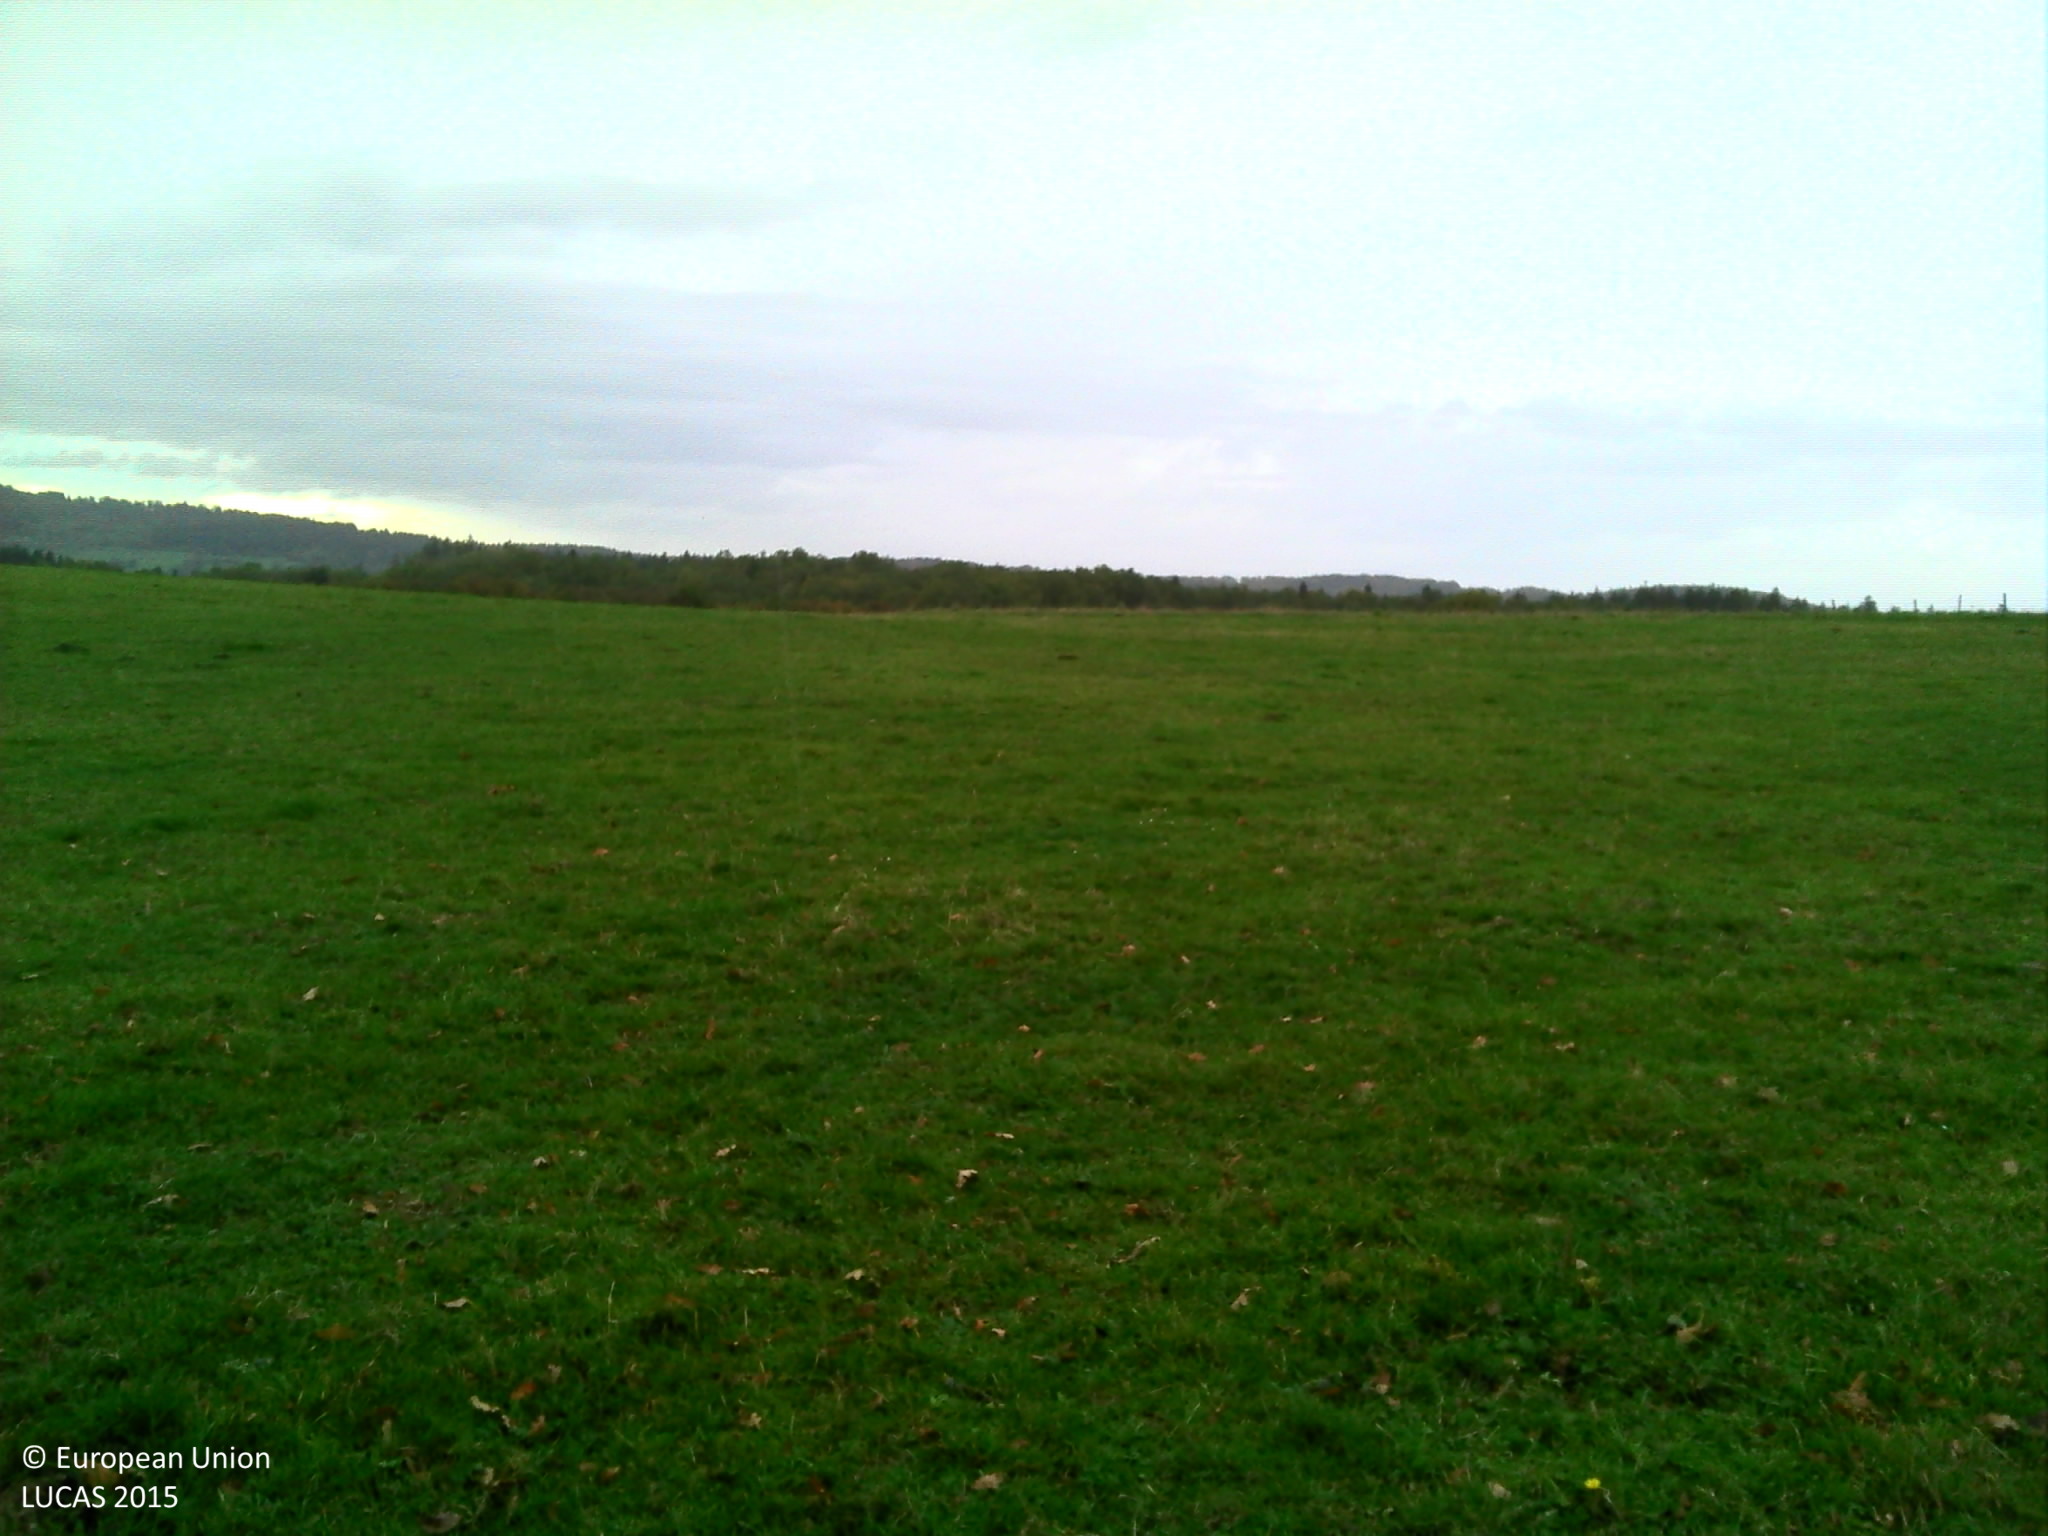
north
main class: Grassland
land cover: Grassland with sparse tree/shrub cover
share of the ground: > 75 %
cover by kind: herbaceous plants 95 %, broadleaved forest trees 5 %
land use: Agriculture (excluding fallow land and kitchen gardens)
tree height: > 5 m
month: October
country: FR
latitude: 46.9887
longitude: 6.2550
